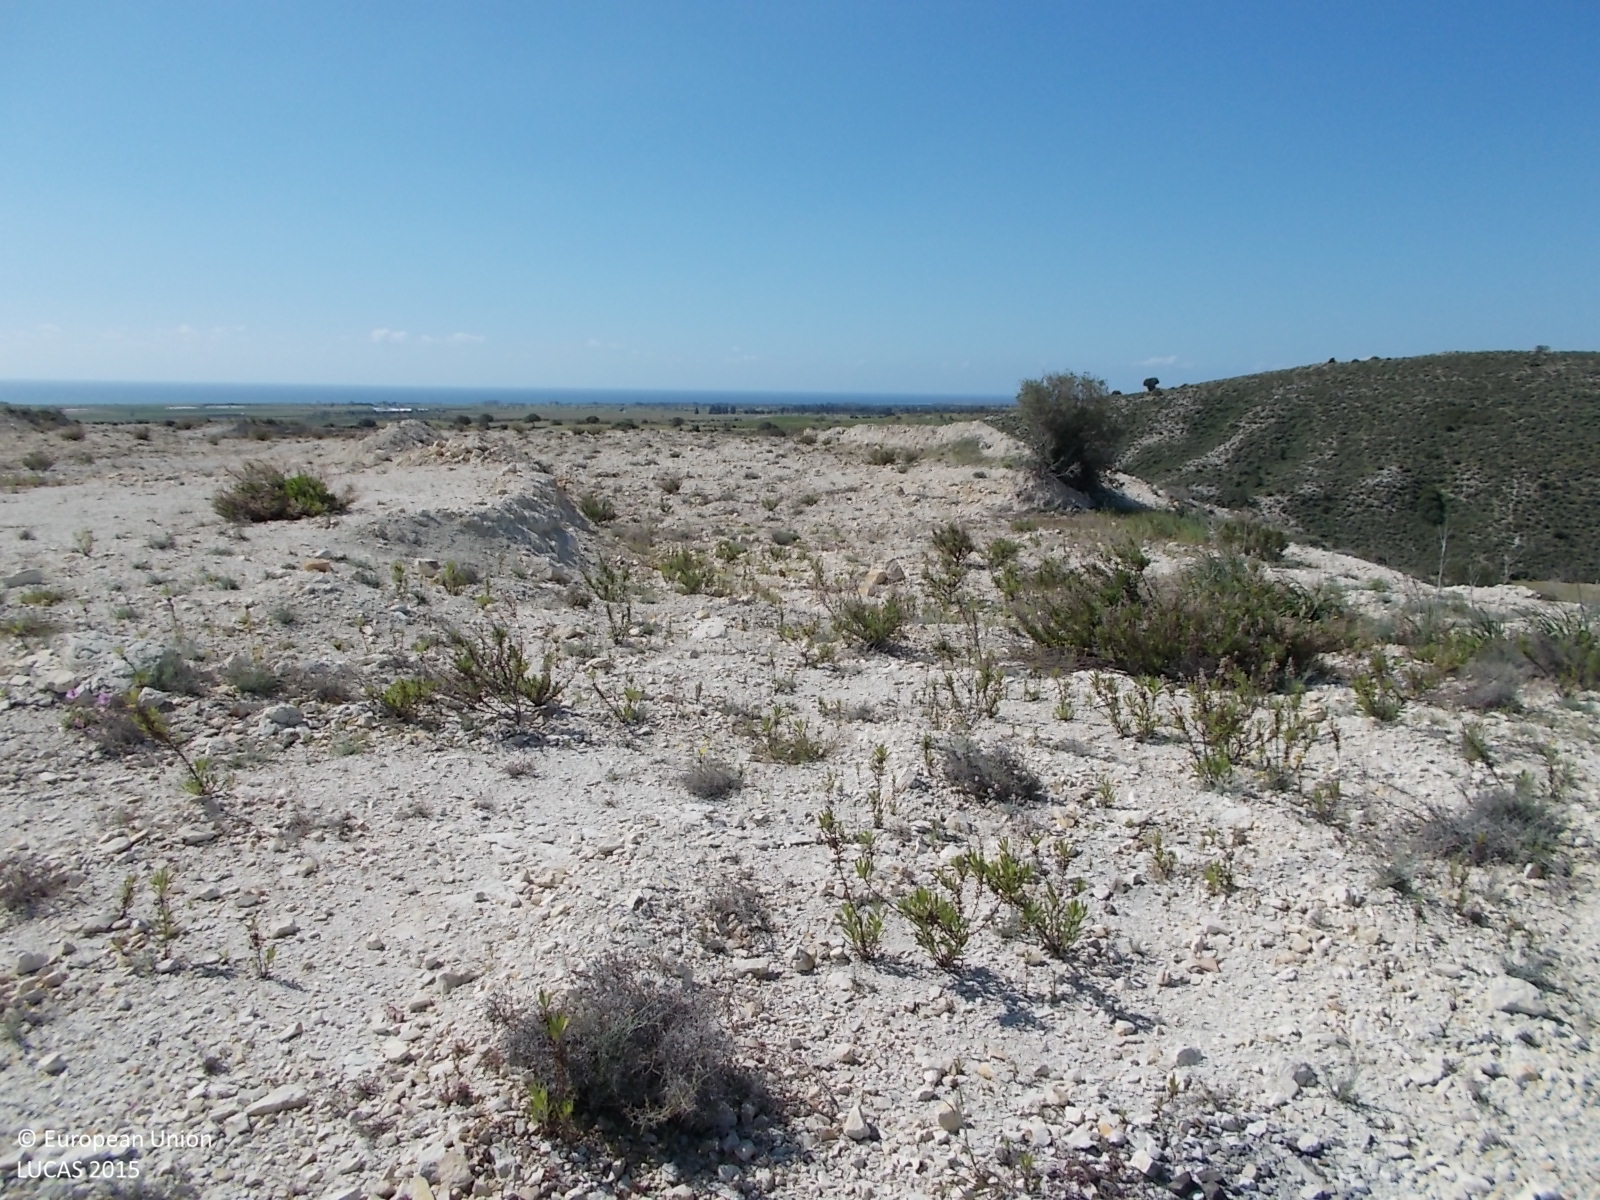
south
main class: Shrubland
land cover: Shrubland without tree cover
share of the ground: 10 - 25 %
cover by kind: unconsolidated bare surface 85 %, shrubs 10 %, herbaceous plants 5 %
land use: Abandoned areas
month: April
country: CY
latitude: 34.8479
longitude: 33.5171
